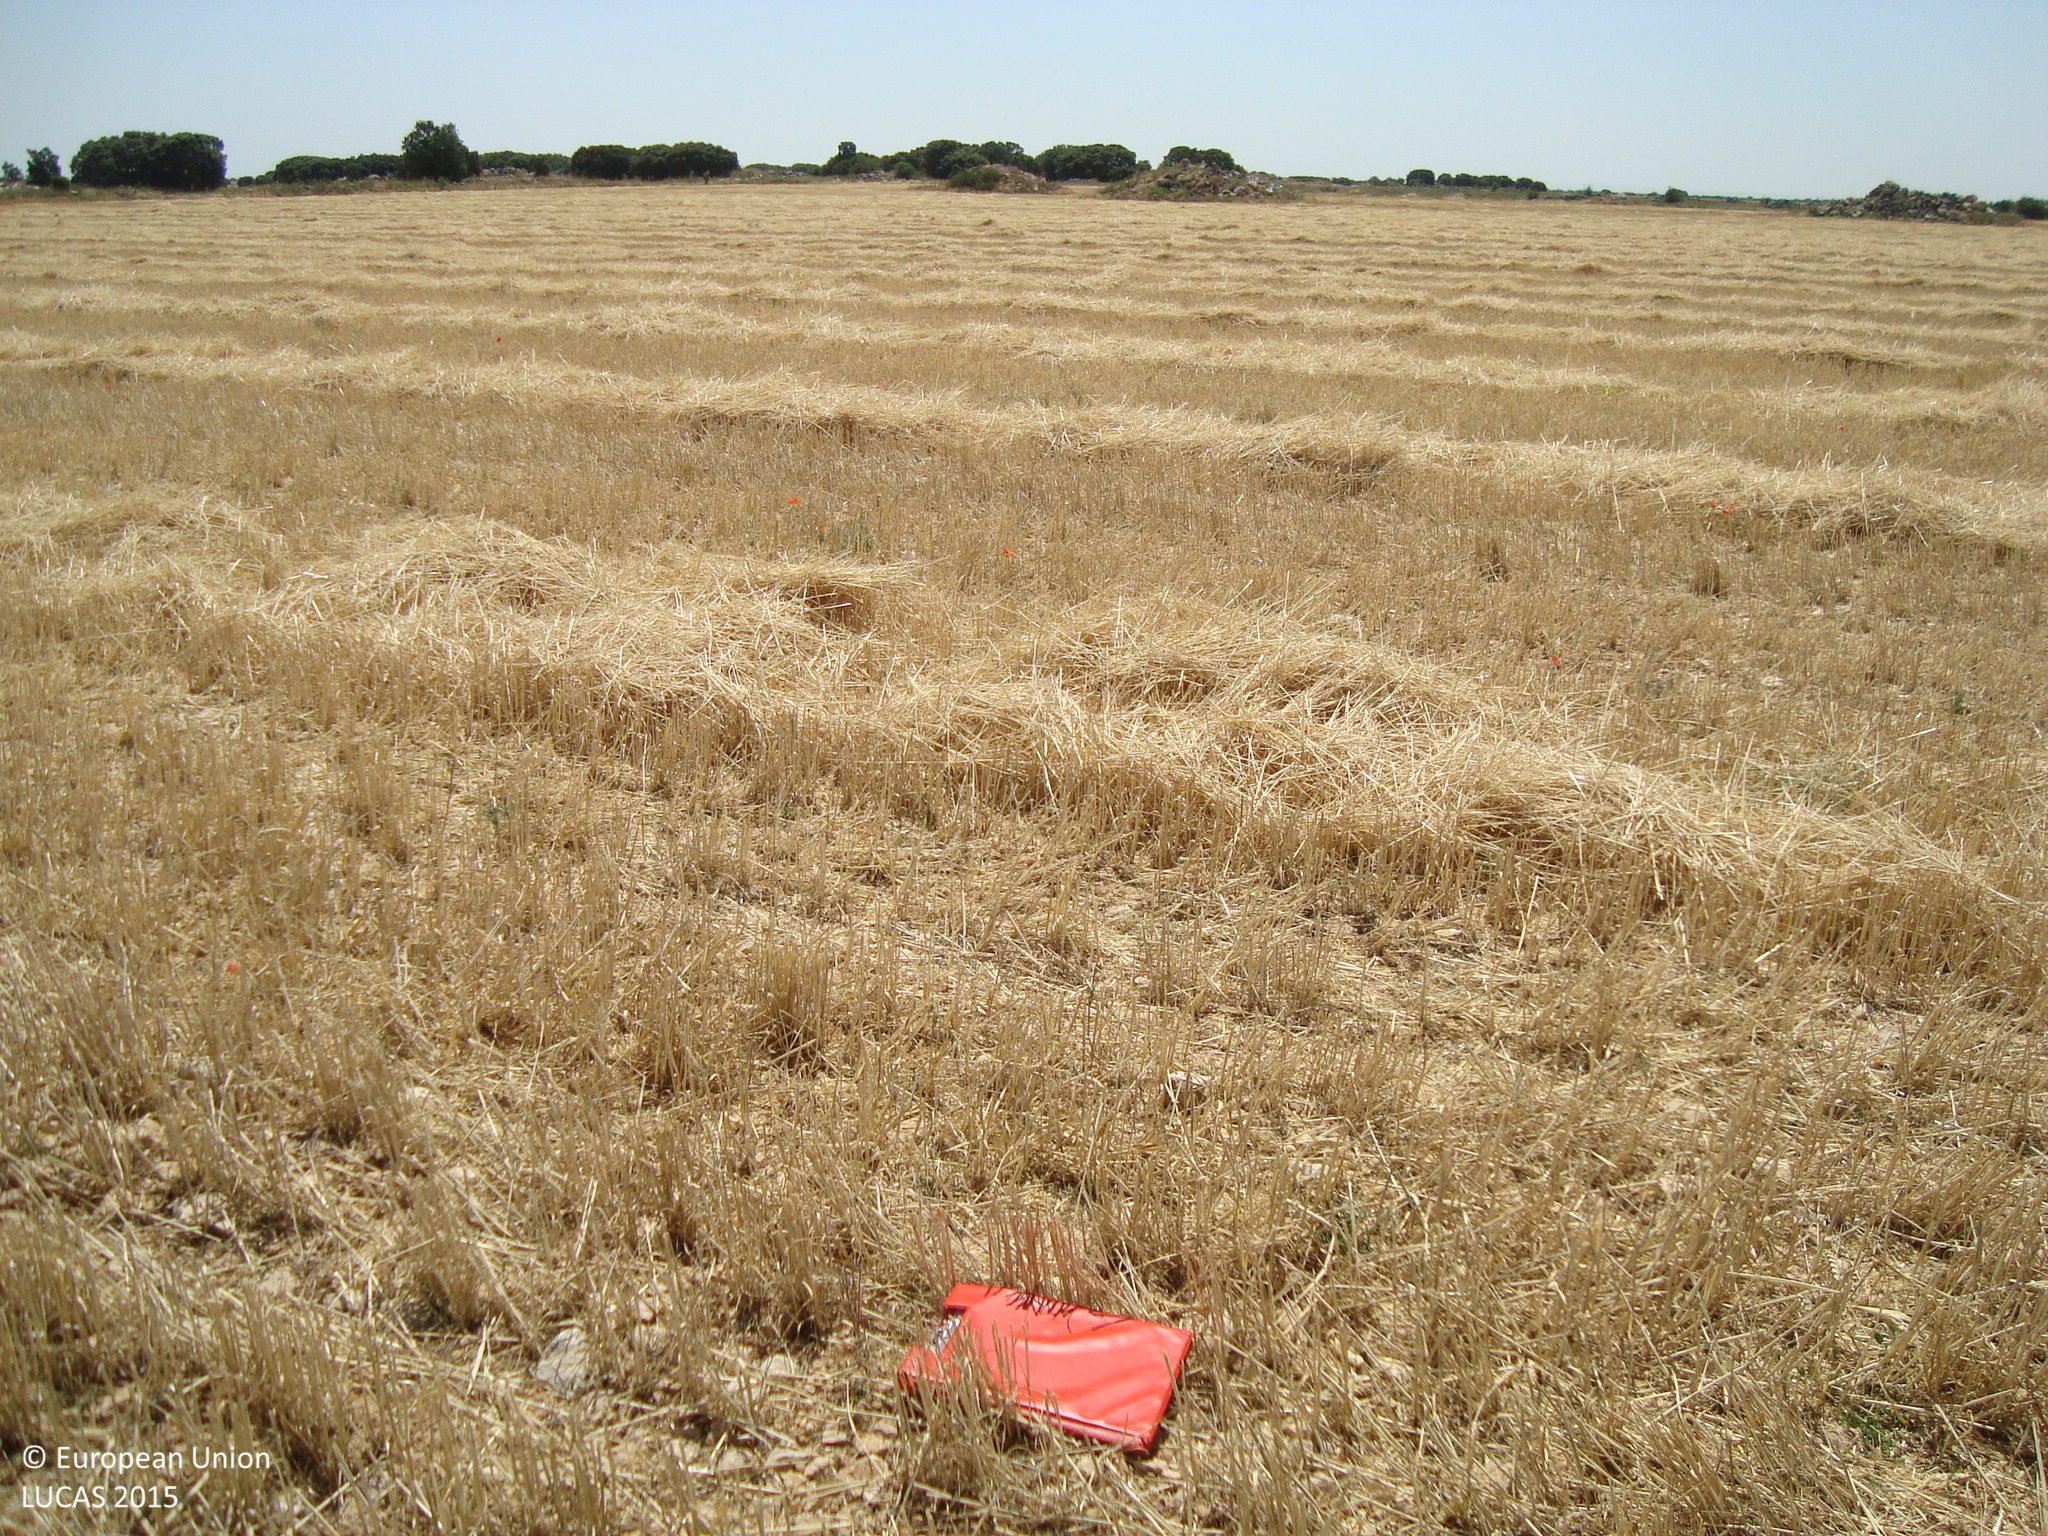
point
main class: Cropland
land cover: Common wheat
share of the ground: > 75 %
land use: Agriculture (excluding fallow land and kitchen gardens)
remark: Harvested field
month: July
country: ES
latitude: 41.8252
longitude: -4.1116
